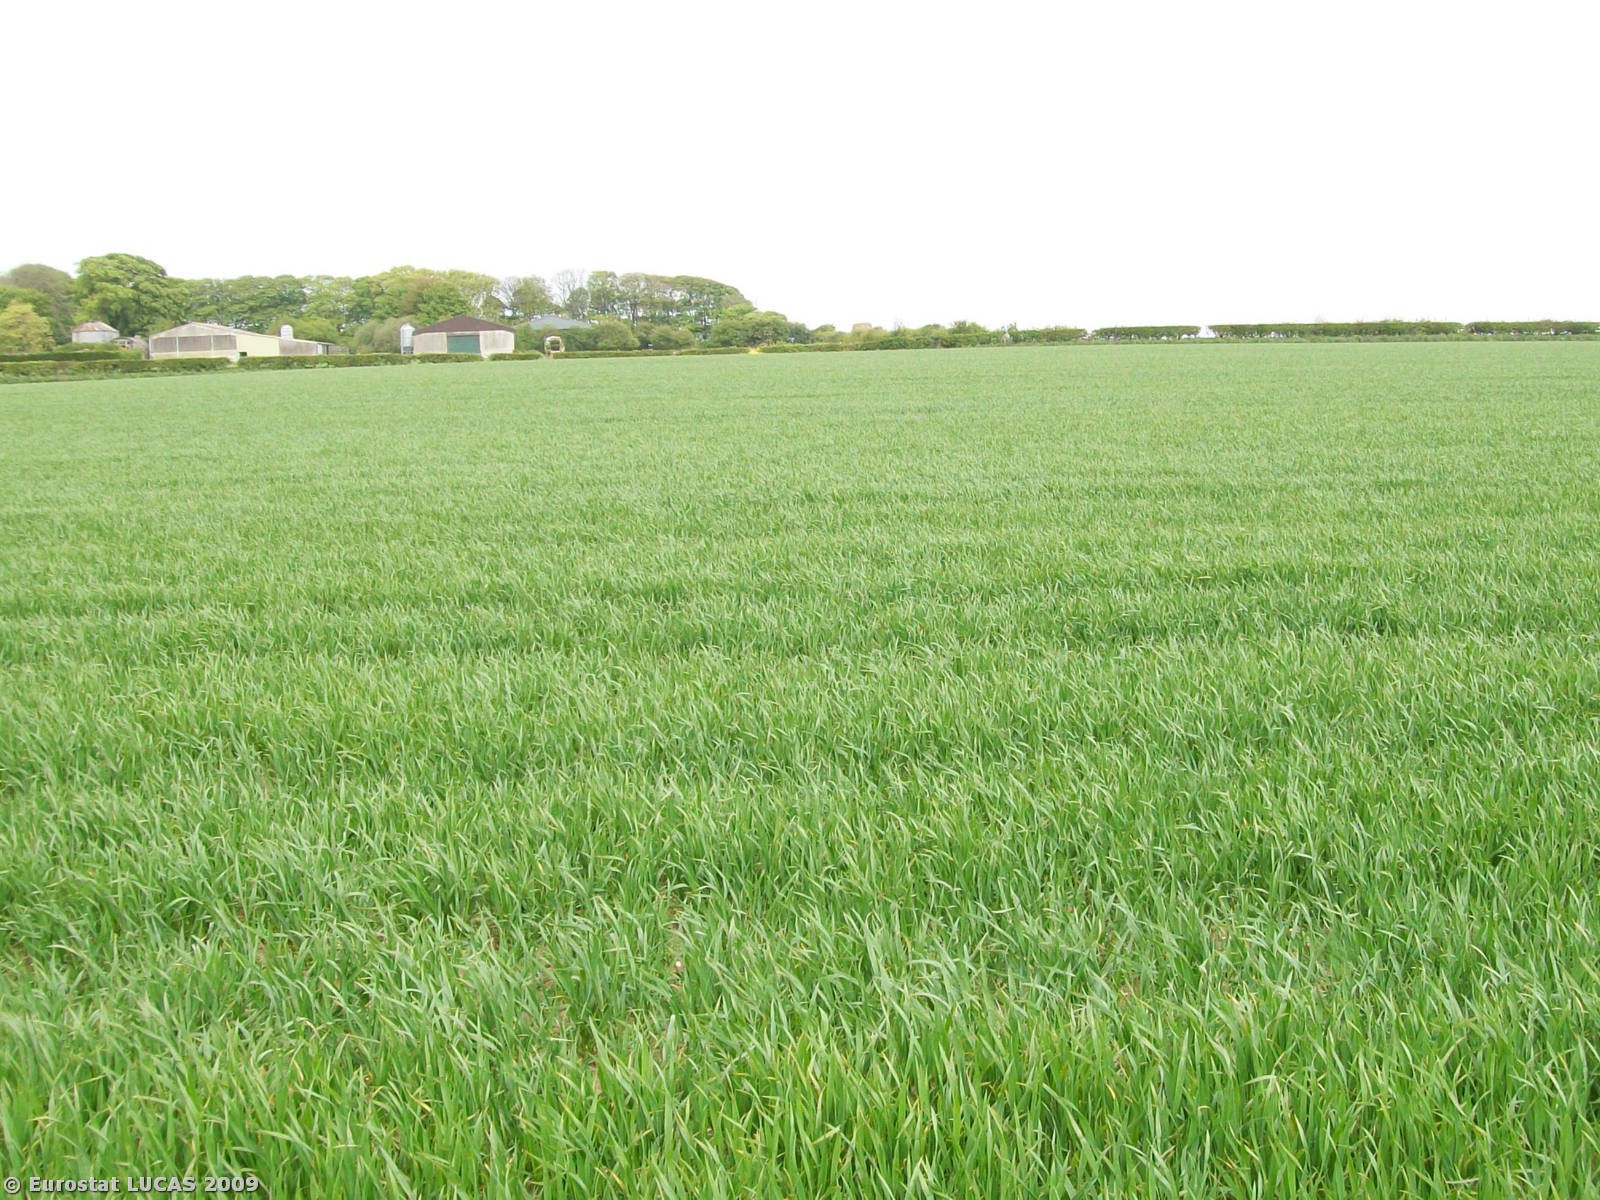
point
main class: Cropland
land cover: Common wheat
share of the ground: > 75 %
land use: Agriculture (excluding fallow land and kitchen gardens)
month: May
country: GB
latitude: 54.1903
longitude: -0.3487
